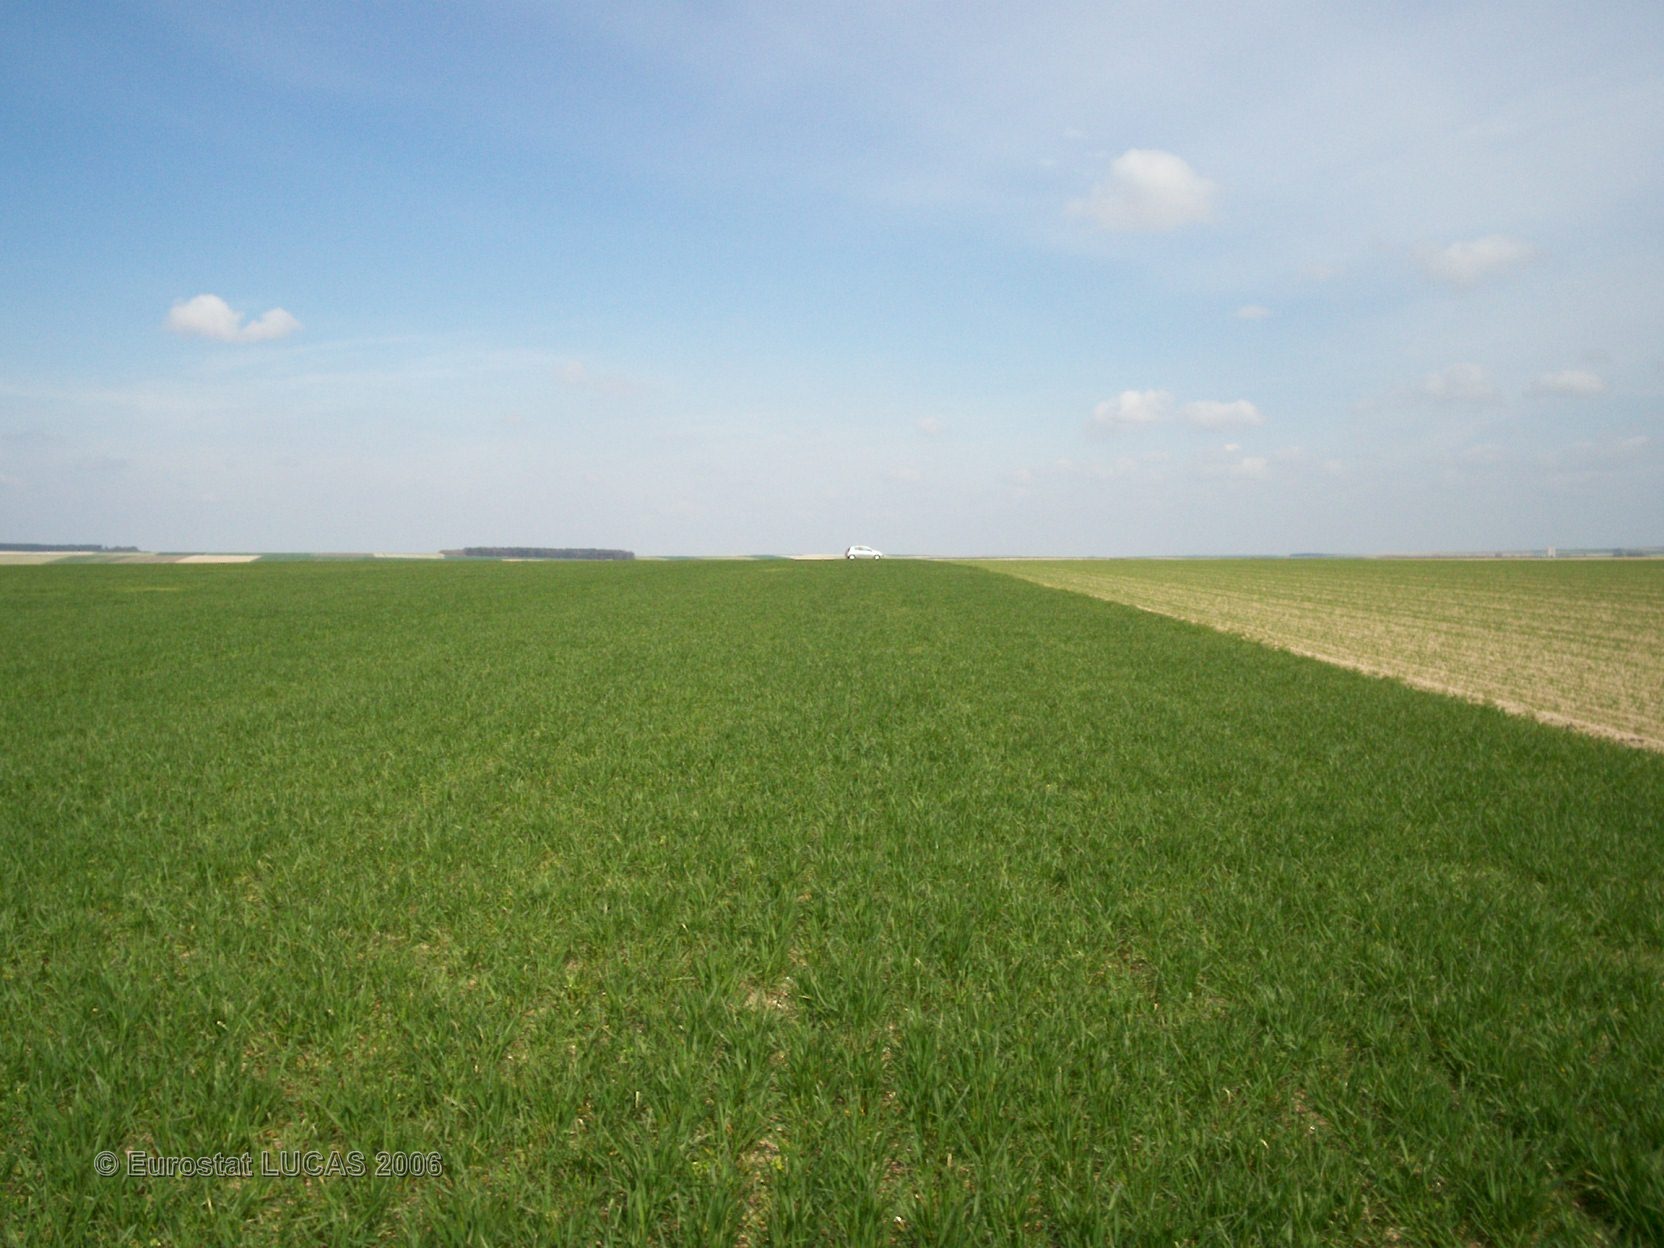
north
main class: Cropland
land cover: Barley
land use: Agriculture (excluding fallow land and kitchen gardens)
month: April
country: FR
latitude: 49.1985
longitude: 4.3832
